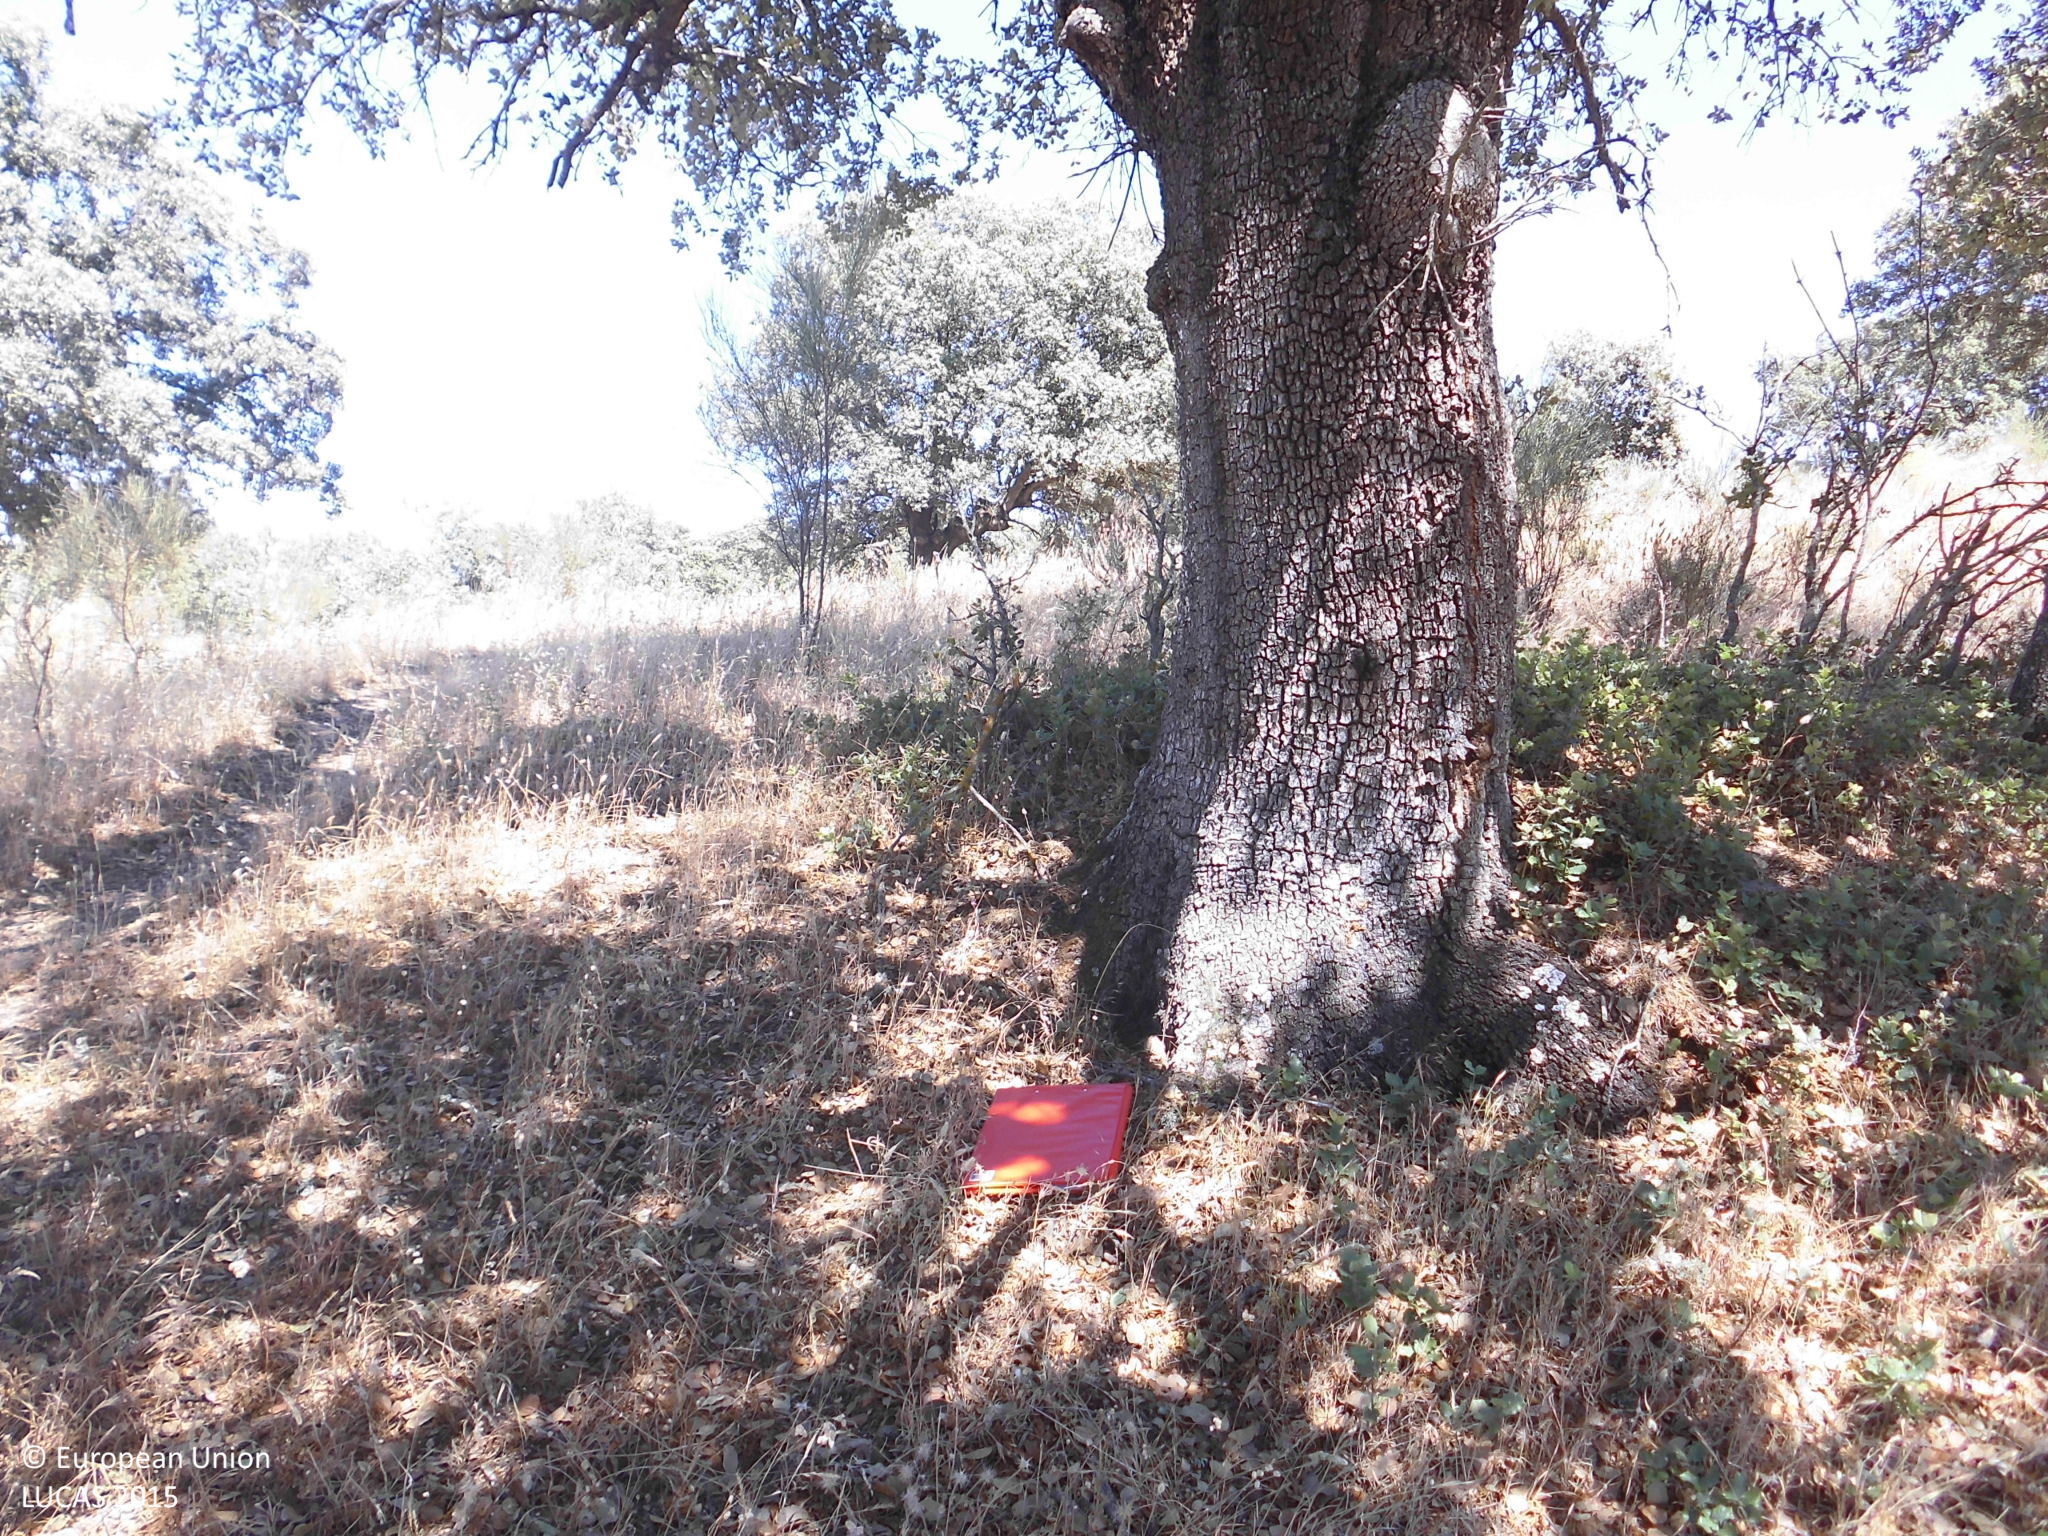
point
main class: Woodland
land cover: Broadleaved woodland
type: broadleaved evergreen forest
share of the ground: 25 - 50 %
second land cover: Grassland without tree/shrub cover
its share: > 75 %
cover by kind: herbaceous plants 65 %, broadleaved forest trees 25 %, shrubs 10 %
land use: Forestry
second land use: Agriculture (excluding fallow land and kitchen gardens)
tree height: > 5 m
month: May
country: ES
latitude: 39.5505
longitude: -6.6584
